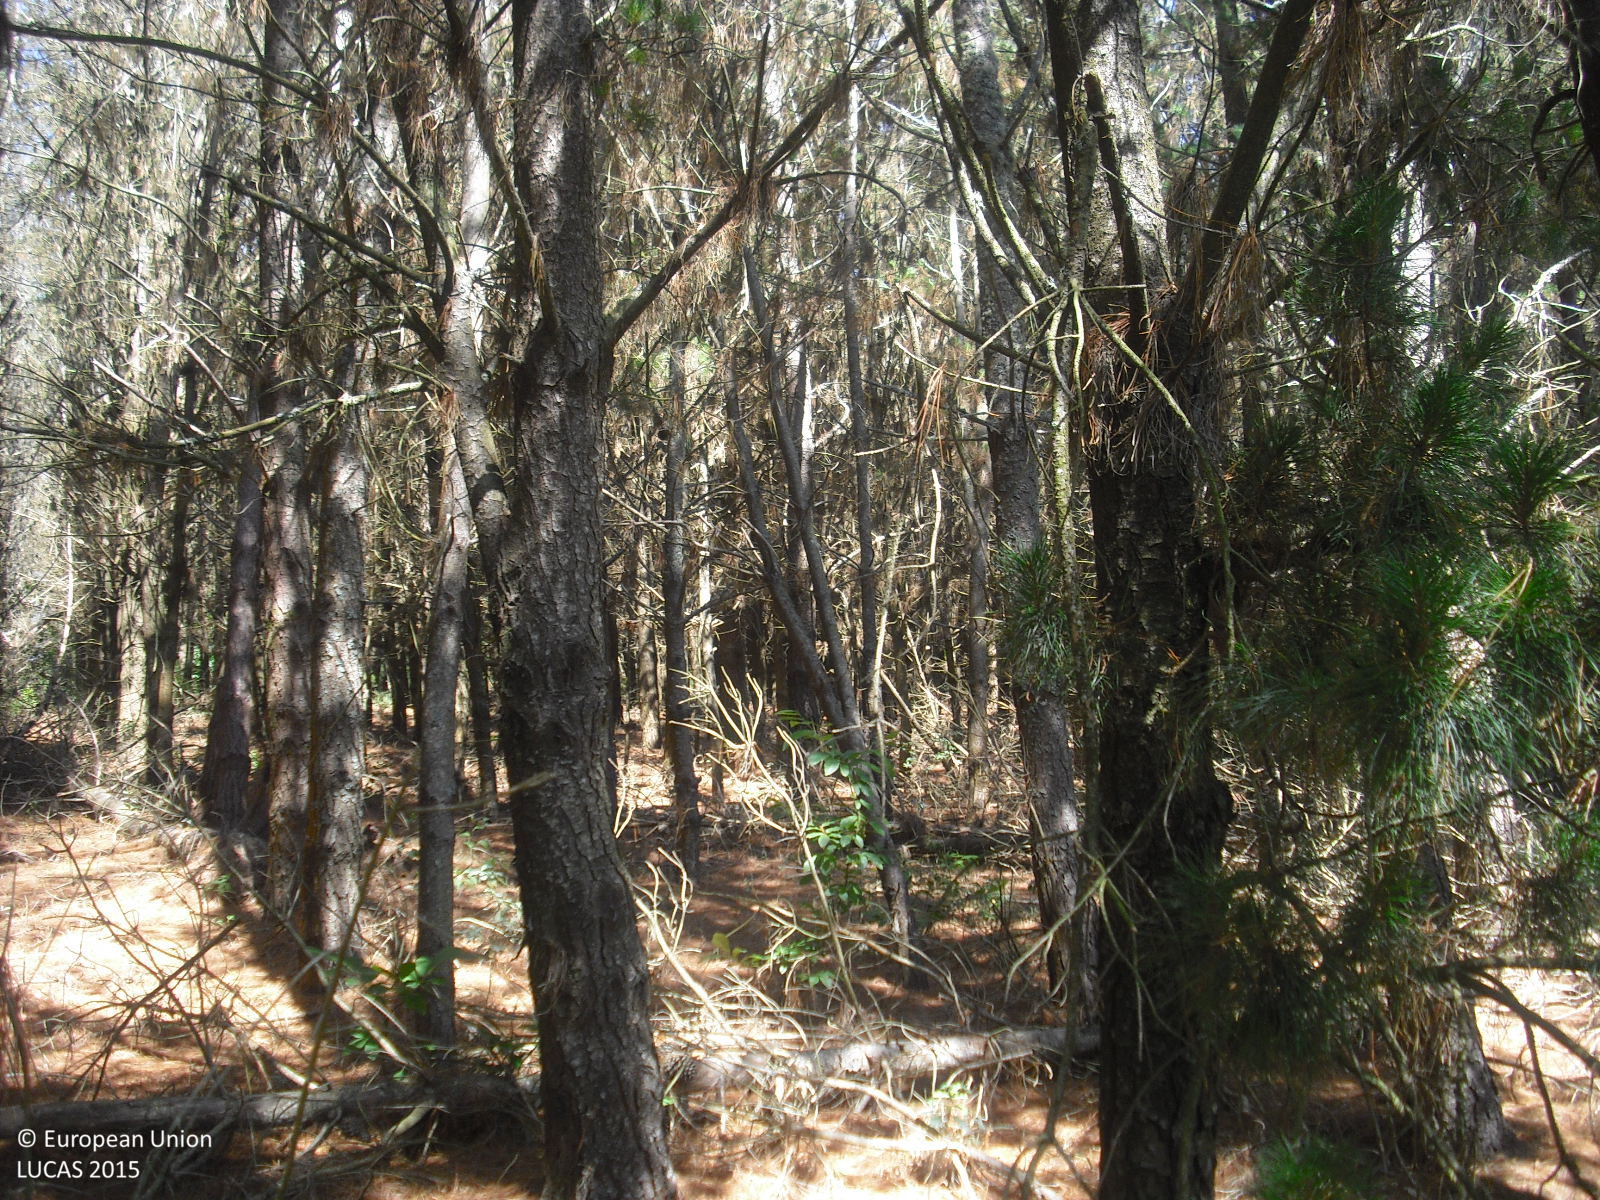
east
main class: Shrubland
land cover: Shrubland with sparse tree cover
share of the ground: > 75 %
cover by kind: shrubs 95 %, broadleaved forest trees 5 %
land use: Abandoned areas
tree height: < 5 m
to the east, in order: Shrubland with sparse tree cover; Pine dominated coniferous woodland; Tracks; Rock outcrops; Fences; Pine dominated coniferous woodland
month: July
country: ES
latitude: 42.6555
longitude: -7.5535
